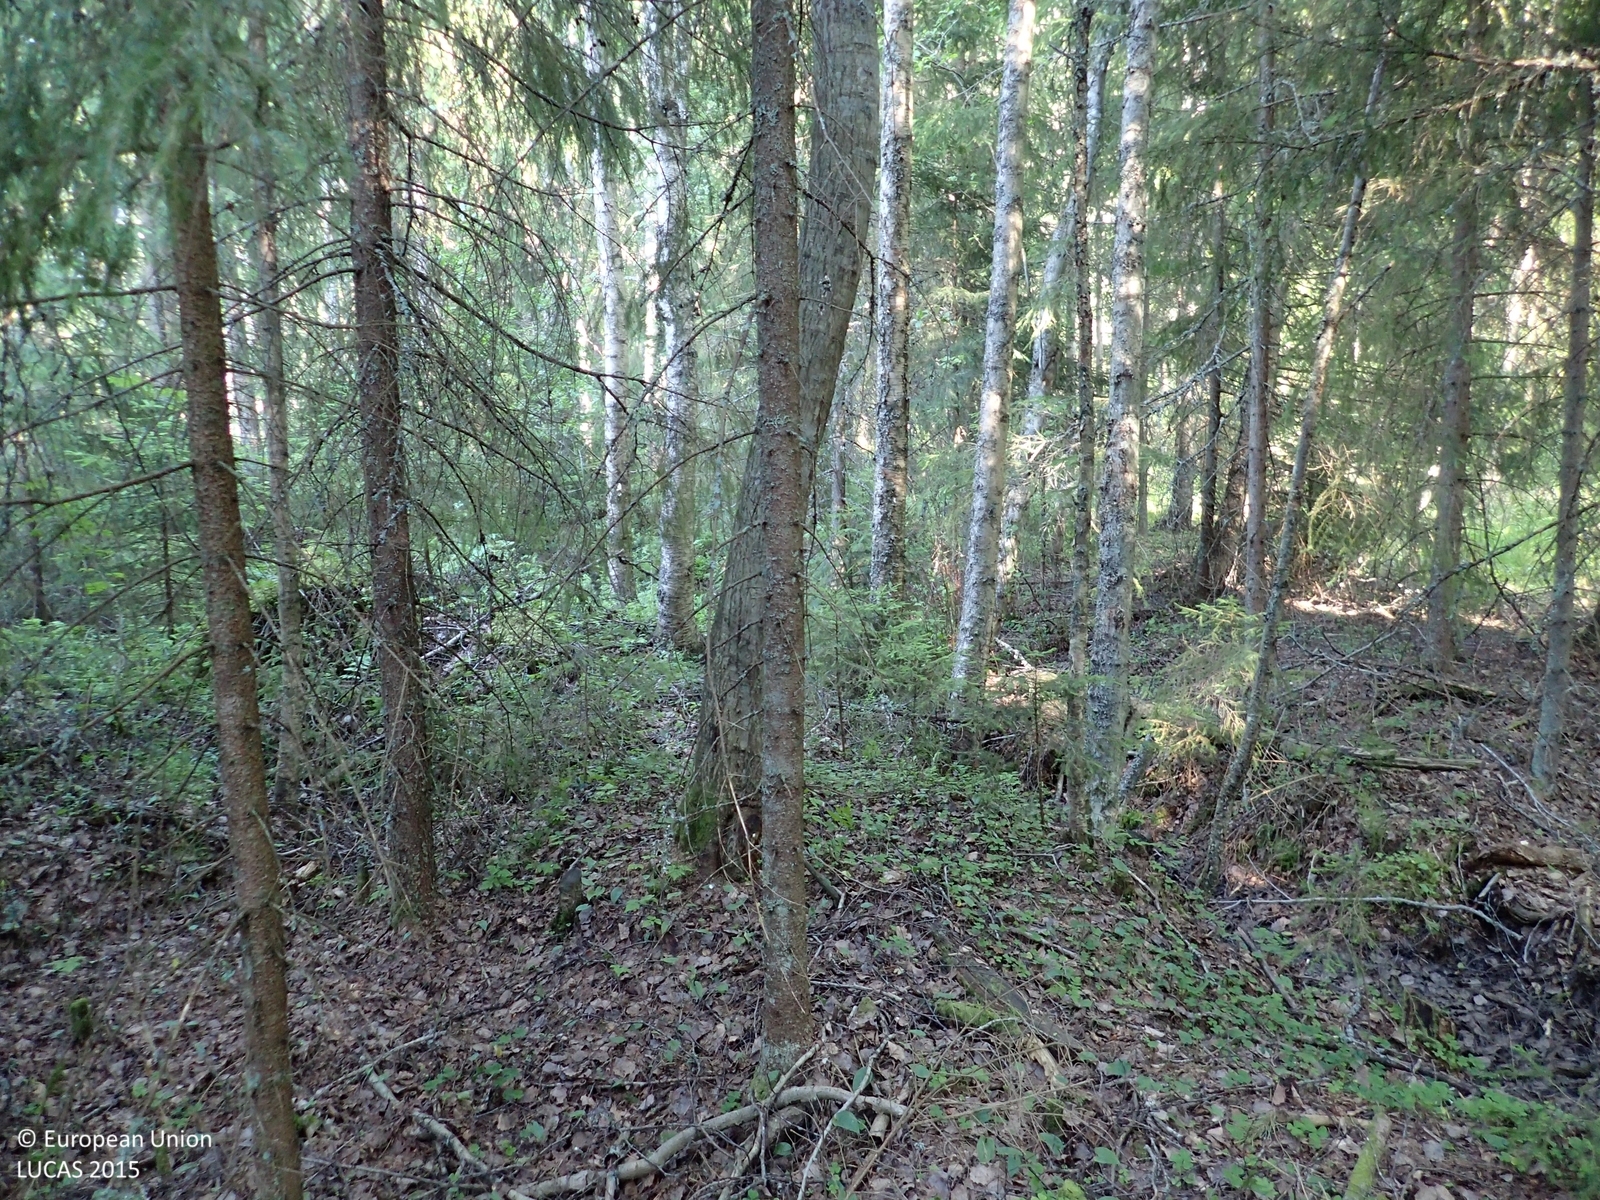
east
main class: Woodland
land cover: Spruce dominated mixed woodland
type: boreal forest
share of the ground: > 75 %
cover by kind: broadleaved forest trees 50 %, coniferous forest trees 40 %, shrubs 5 %, herbaceous plants 5 %
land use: Forestry
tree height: > 5 m
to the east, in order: Spruce dominated mixed woodland; Ditches and canals; Spruce dominated mixed woodland; Other mixed woodland
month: July
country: FI
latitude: 62.7991
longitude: 21.3936
